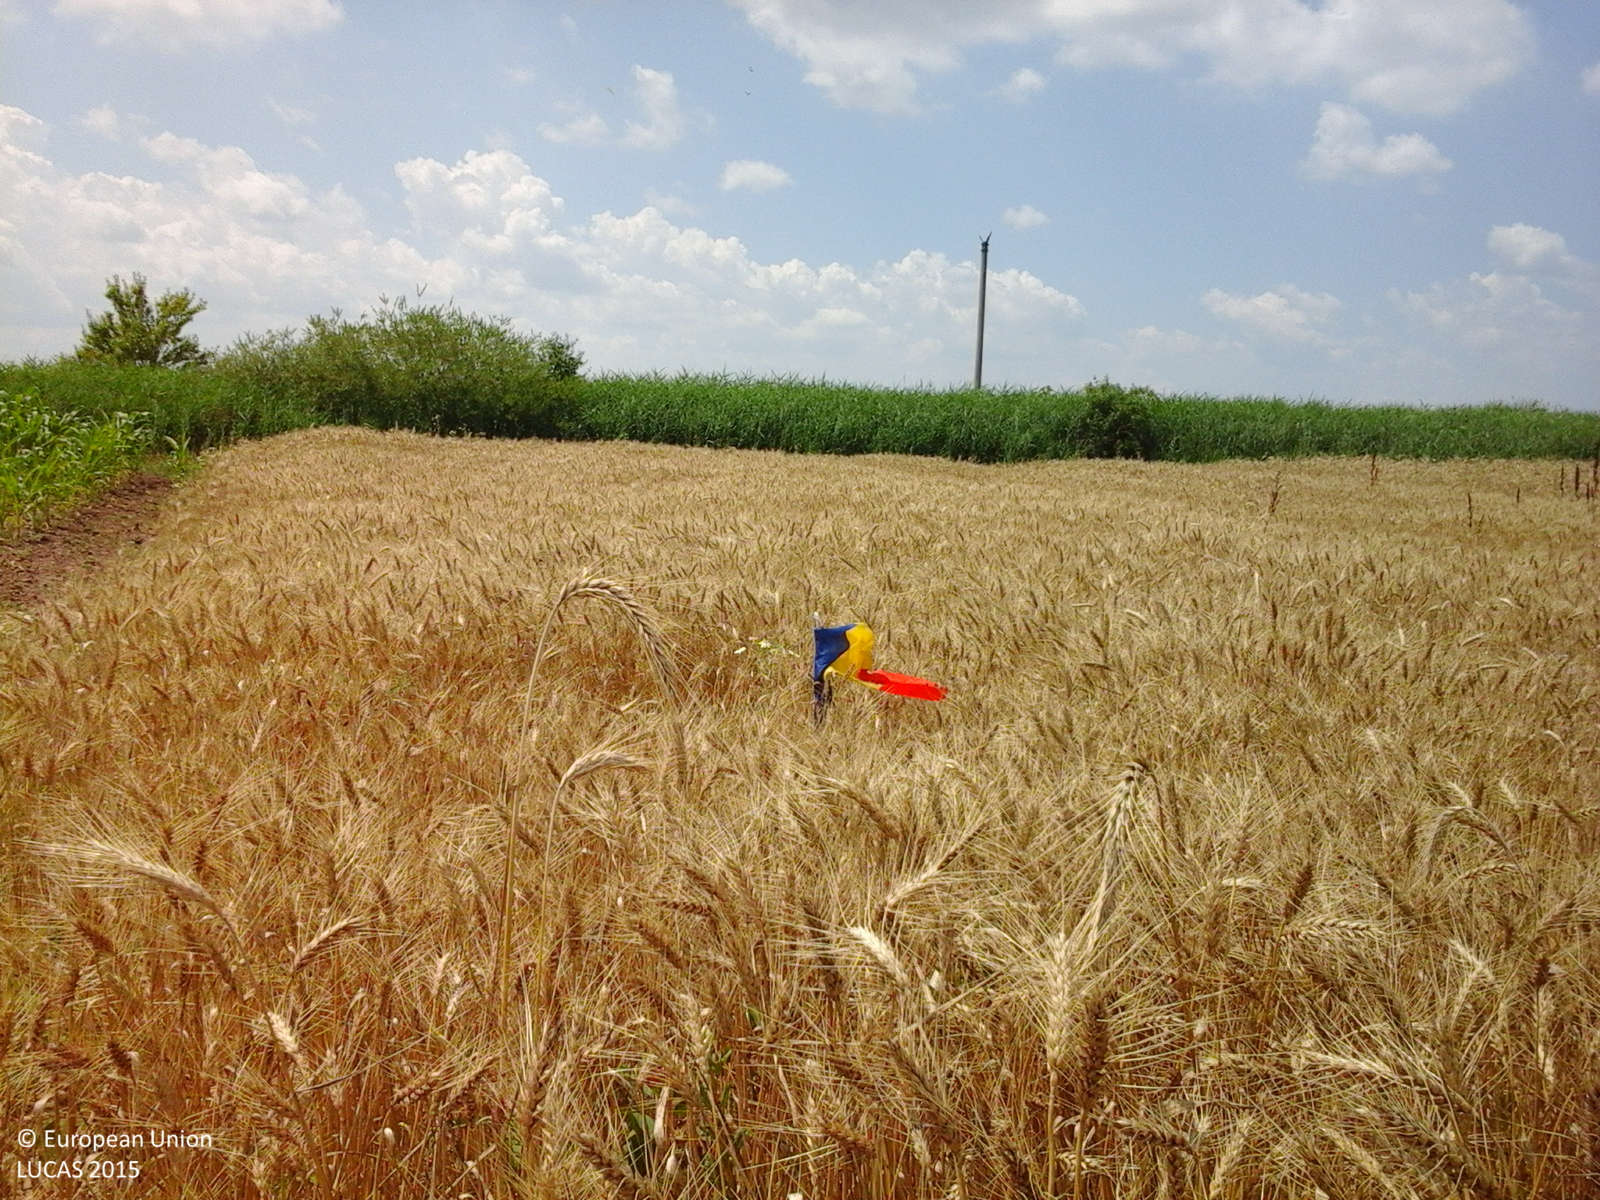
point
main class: Cropland
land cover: Common wheat
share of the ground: > 75 %
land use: Agriculture (excluding fallow land and kitchen gardens)
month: July
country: RO
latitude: 44.4405
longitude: 25.6362
